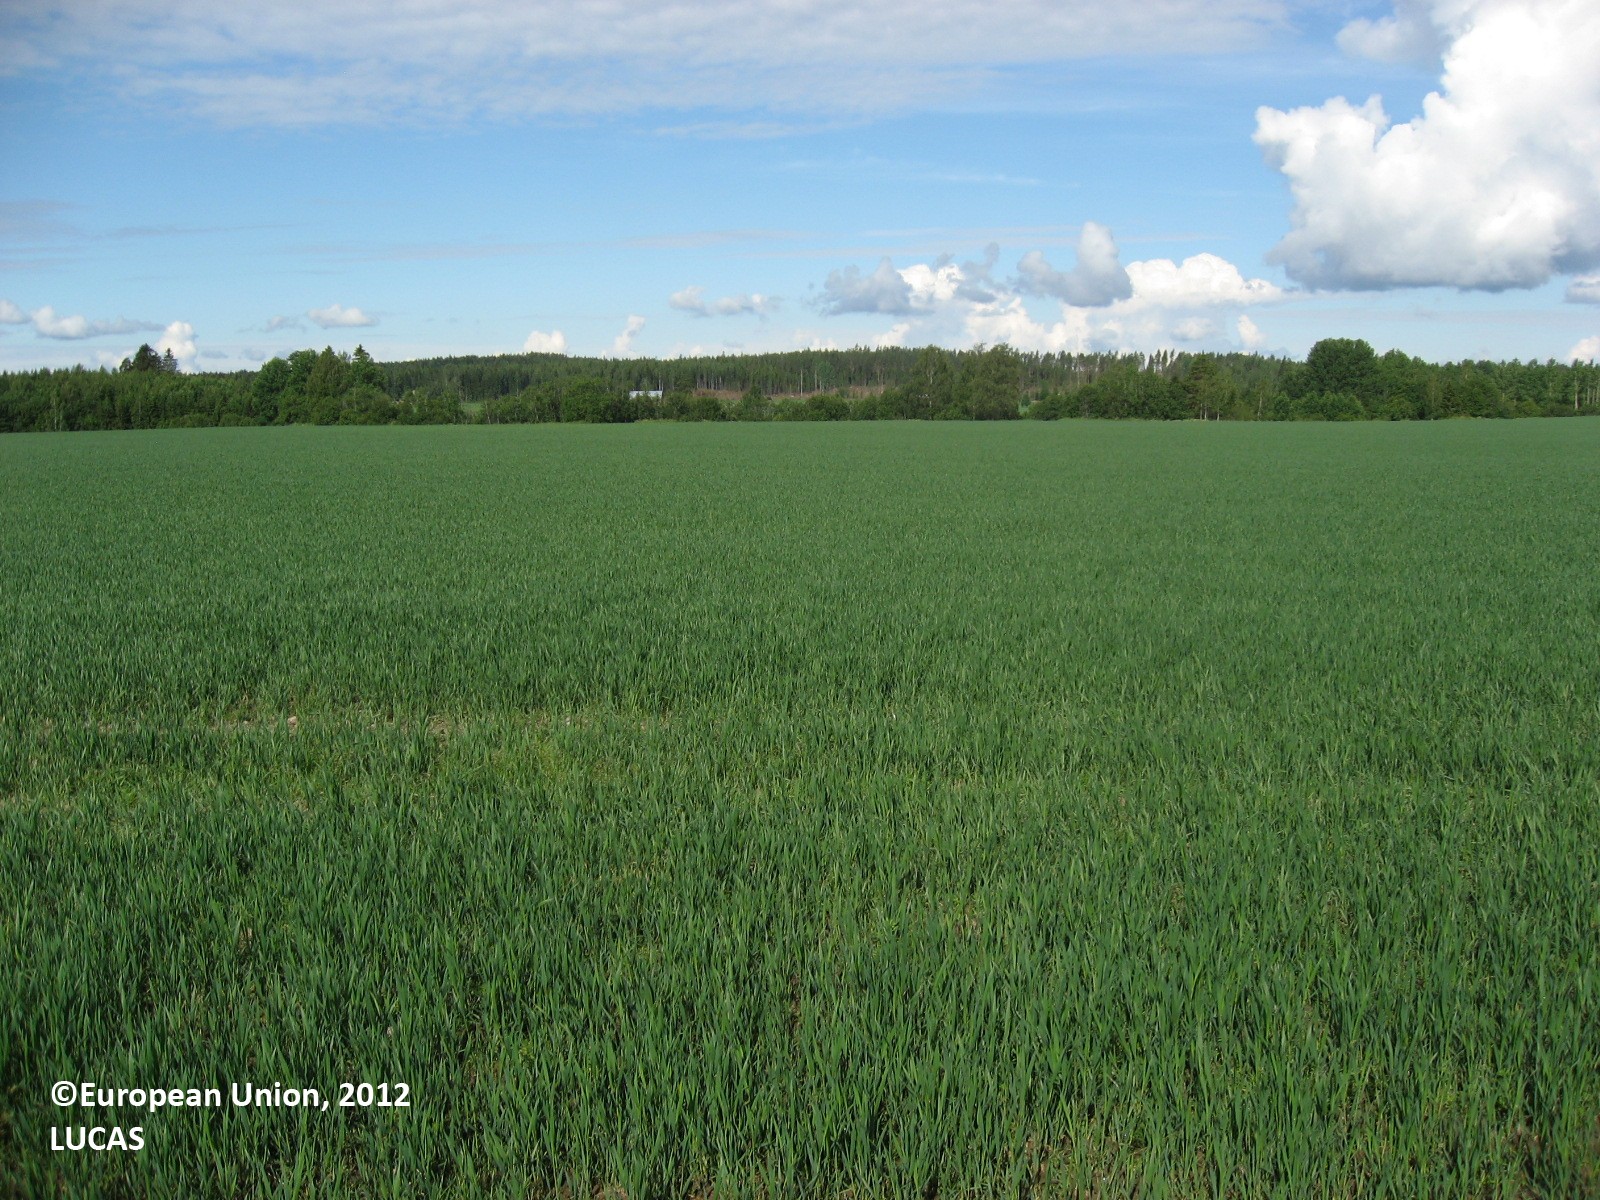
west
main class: Cropland
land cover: Common wheat
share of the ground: 50 - 75 %
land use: Agriculture (excluding fallow land and kitchen gardens)
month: June
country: FI
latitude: 60.6908
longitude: 26.2069
